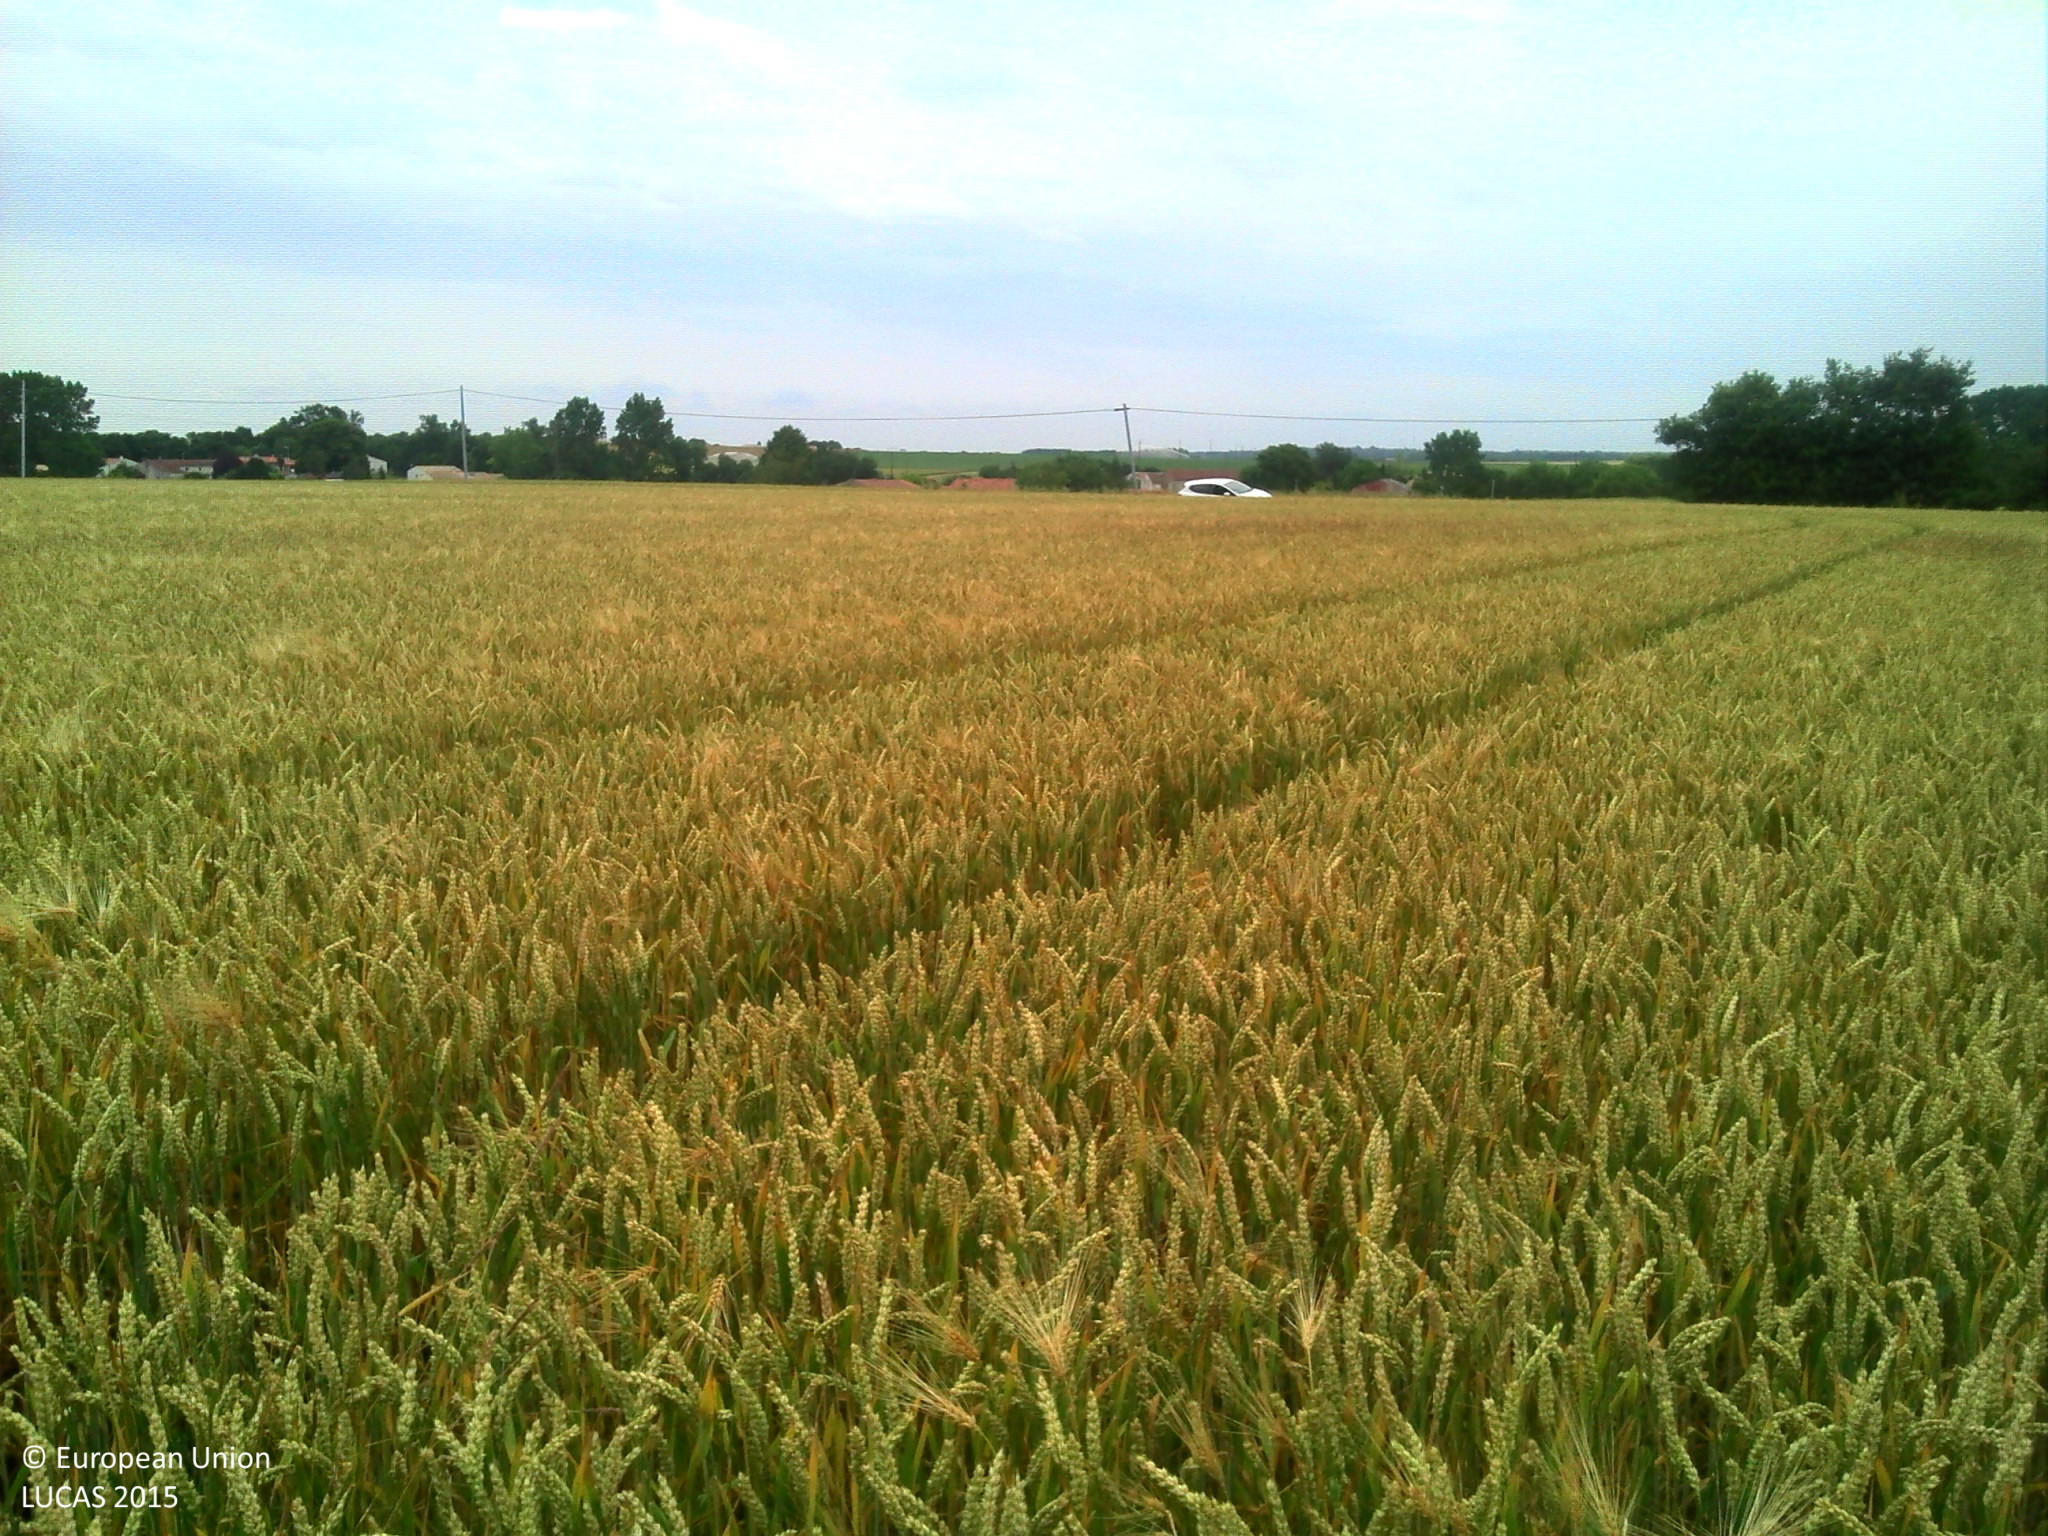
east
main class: Cropland
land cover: Common wheat
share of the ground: > 75 %
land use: Agriculture (excluding fallow land and kitchen gardens)
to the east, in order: Common wheat; Abandoned hedges; Grass margins; Paved roads, cycling and walking lanes; Grass margins; Common wheat
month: June
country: FR
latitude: 45.9508
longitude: -0.7732
